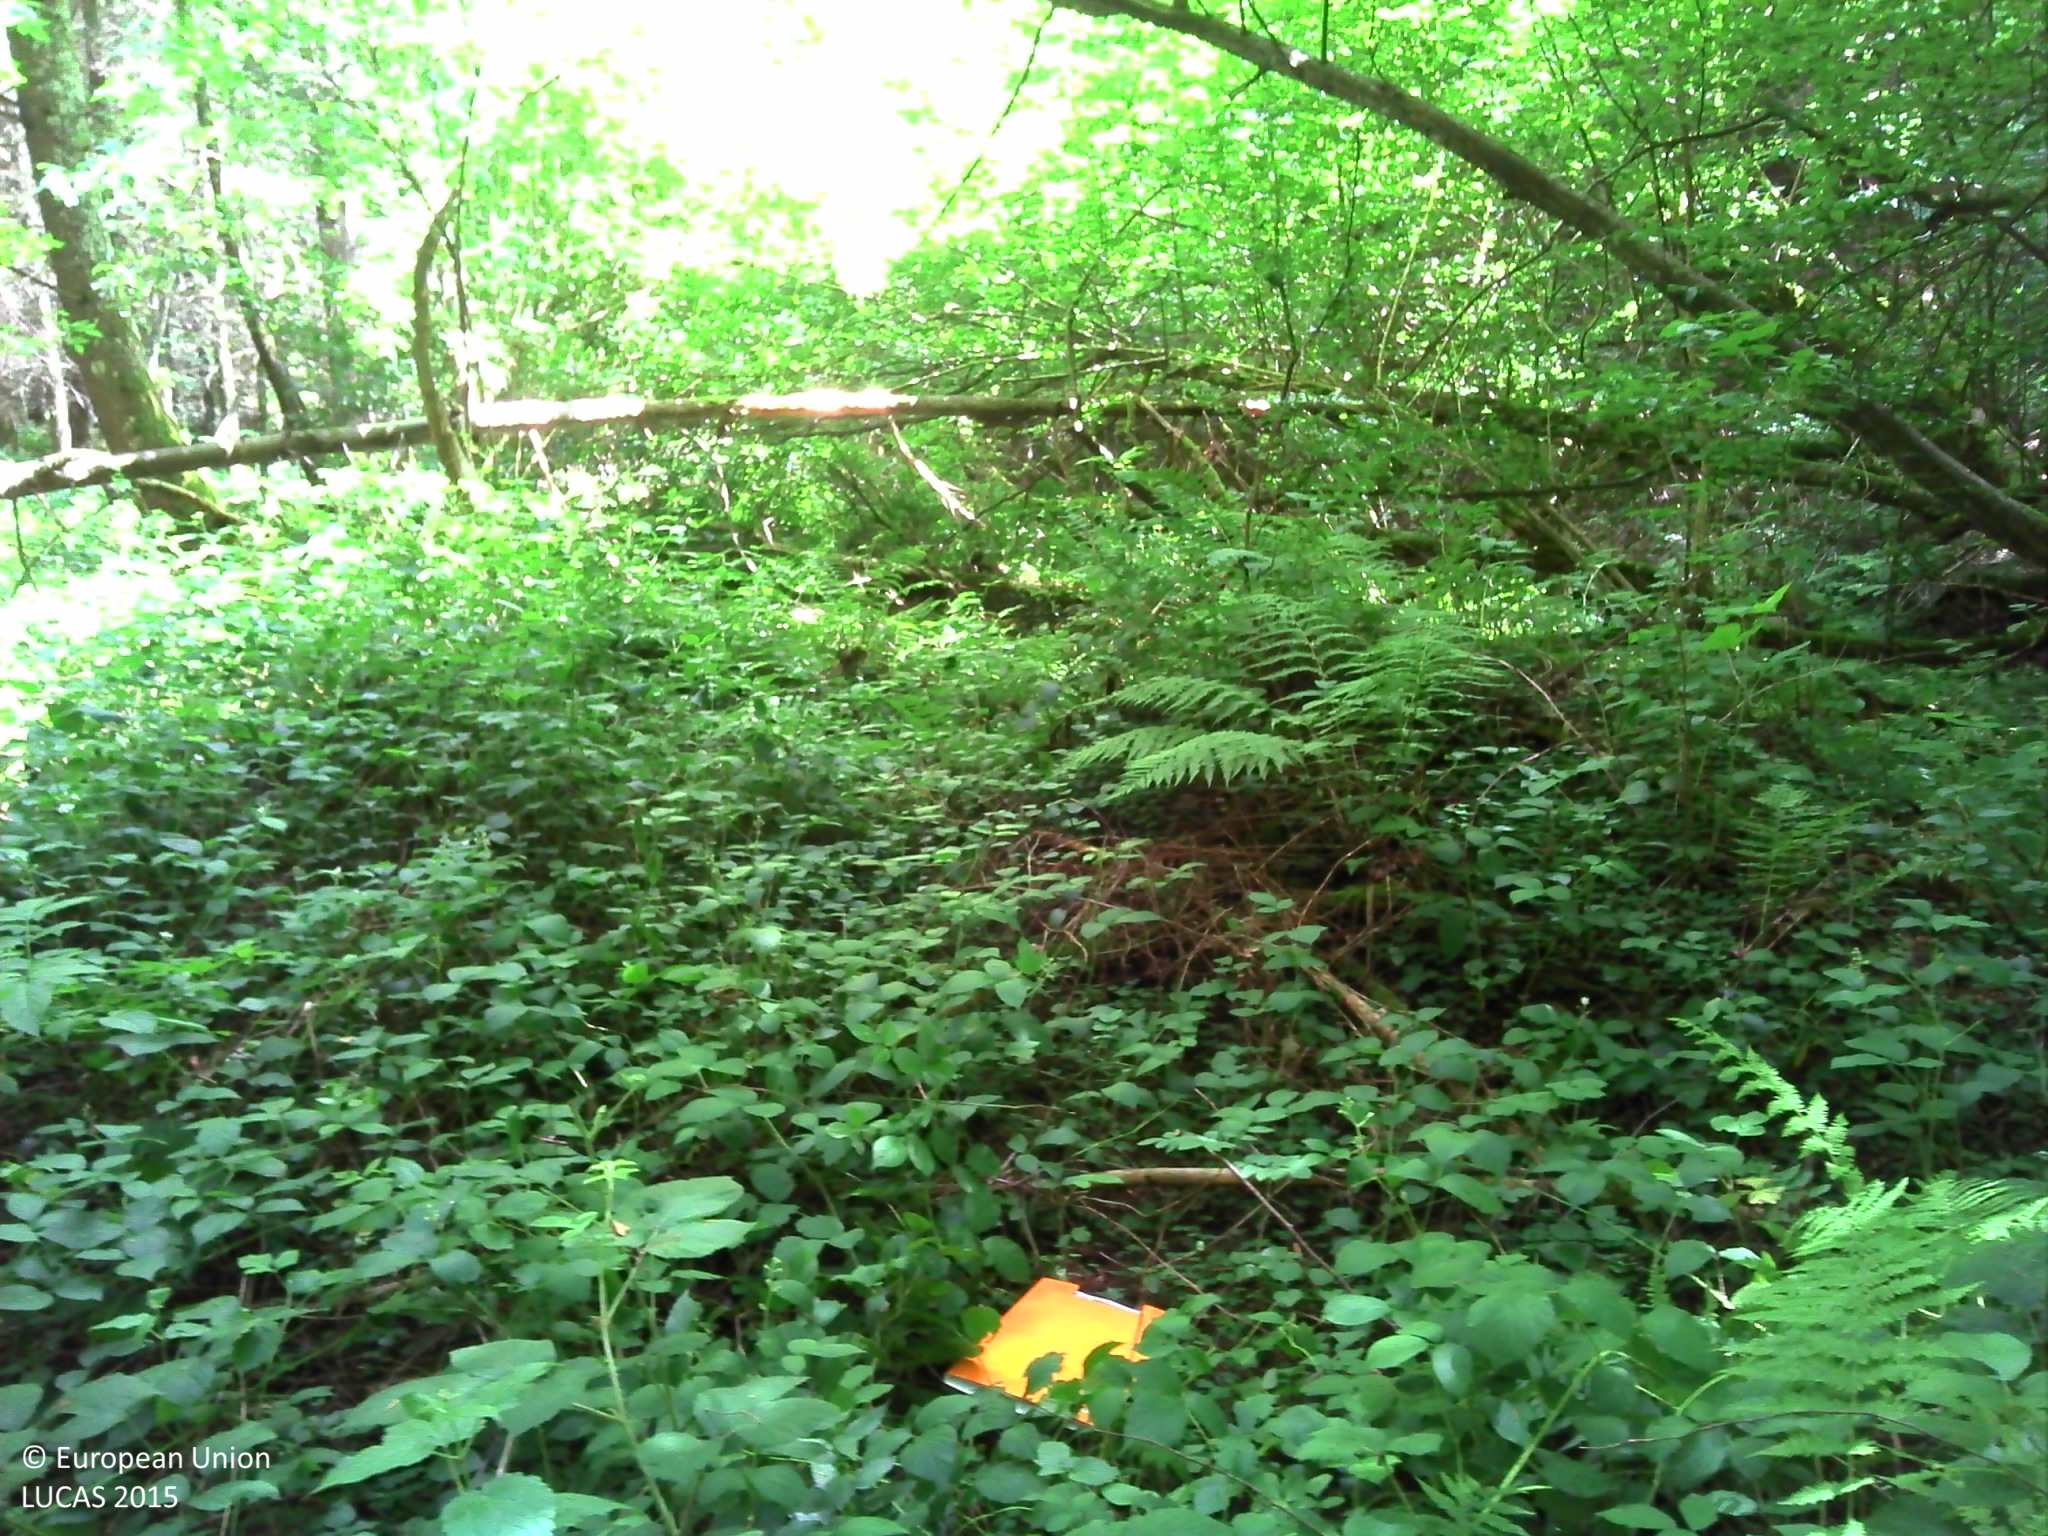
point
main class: Woodland
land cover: Pine dominated mixed woodland
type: acidophilous oak and oak-birch forest
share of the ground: > 75 %
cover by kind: broadleaved forest trees 70 %, coniferous forest trees 25 %, herbaceous plants 5 %
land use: Forestry
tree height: > 5 m
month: June
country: FR
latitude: 46.1591
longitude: 3.0184
